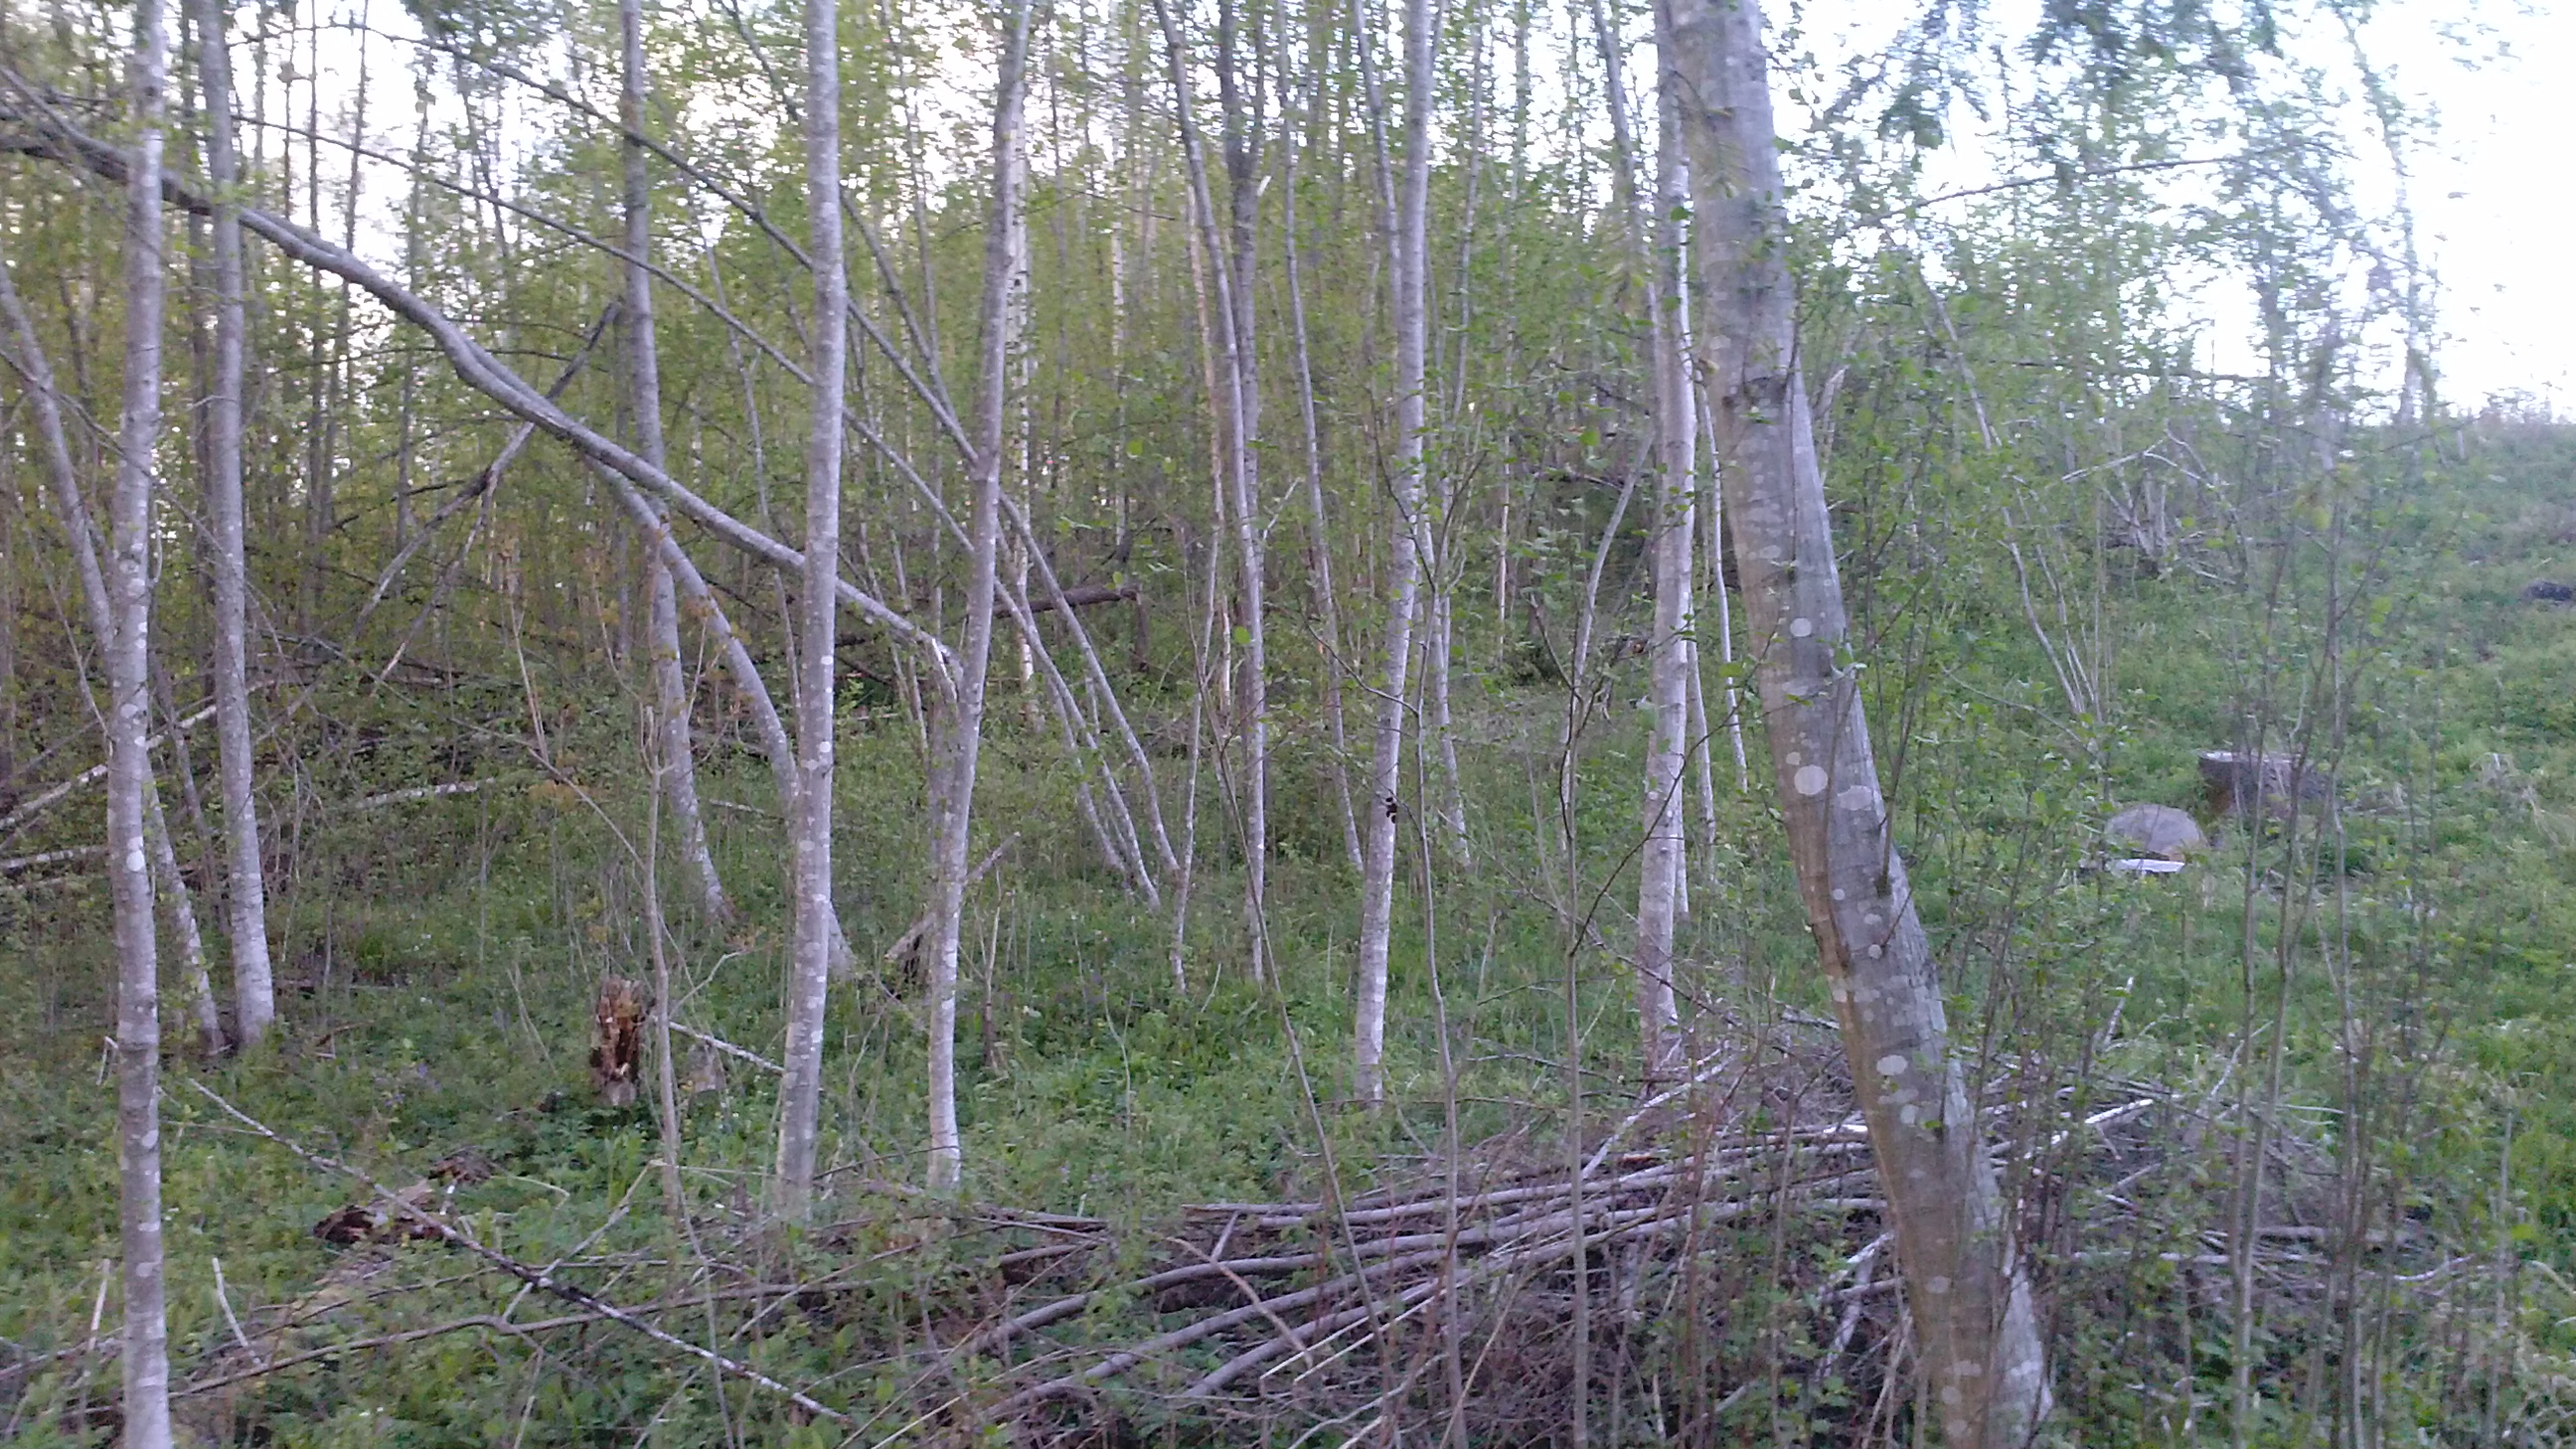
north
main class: Woodland
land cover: Broadleaved woodland
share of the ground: 50 - 75 %
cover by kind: broadleaved forest trees 50 %, shrubs 50 %
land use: Forestry
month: May
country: LV
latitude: 56.0707
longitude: 27.8143
